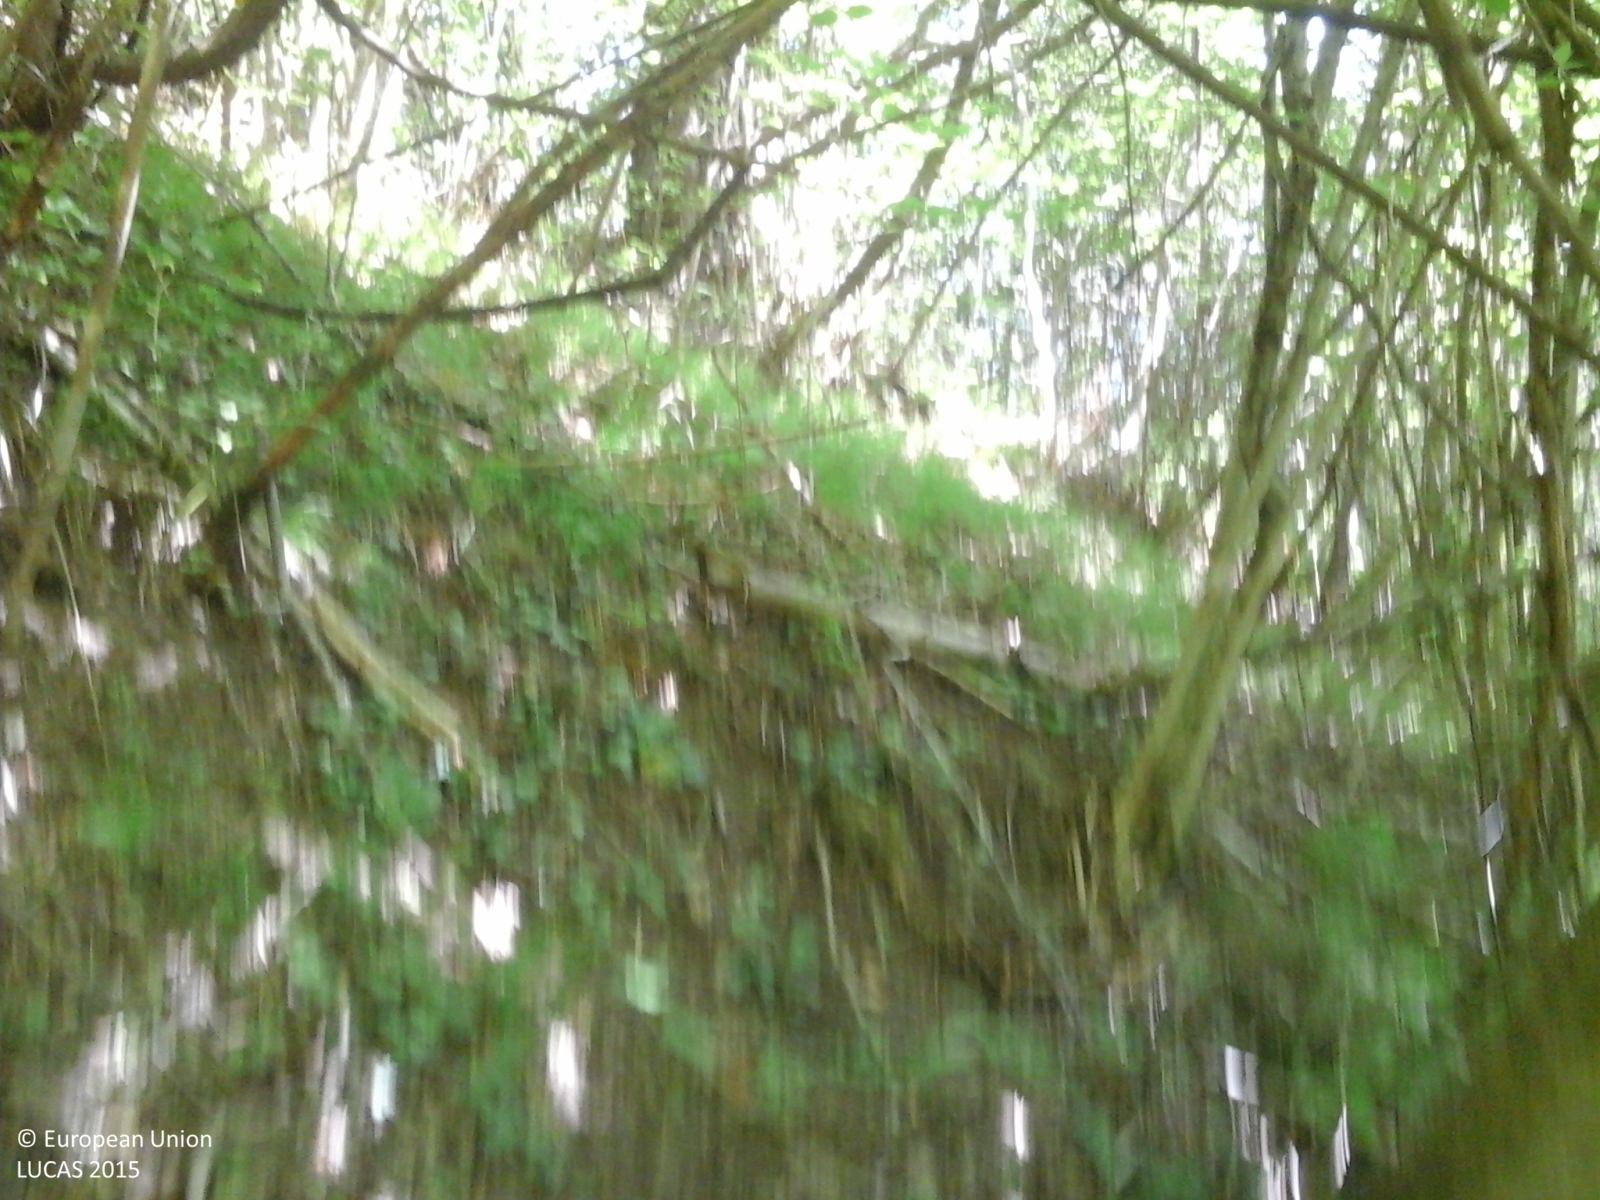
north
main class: Woodland
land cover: Broadleaved woodland
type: thermophilous deciduous forest
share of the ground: > 75 %
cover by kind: broadleaved forest trees 100 %
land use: Forestry
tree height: > 5 m
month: May
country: IT
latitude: 46.0592
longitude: 10.8906
